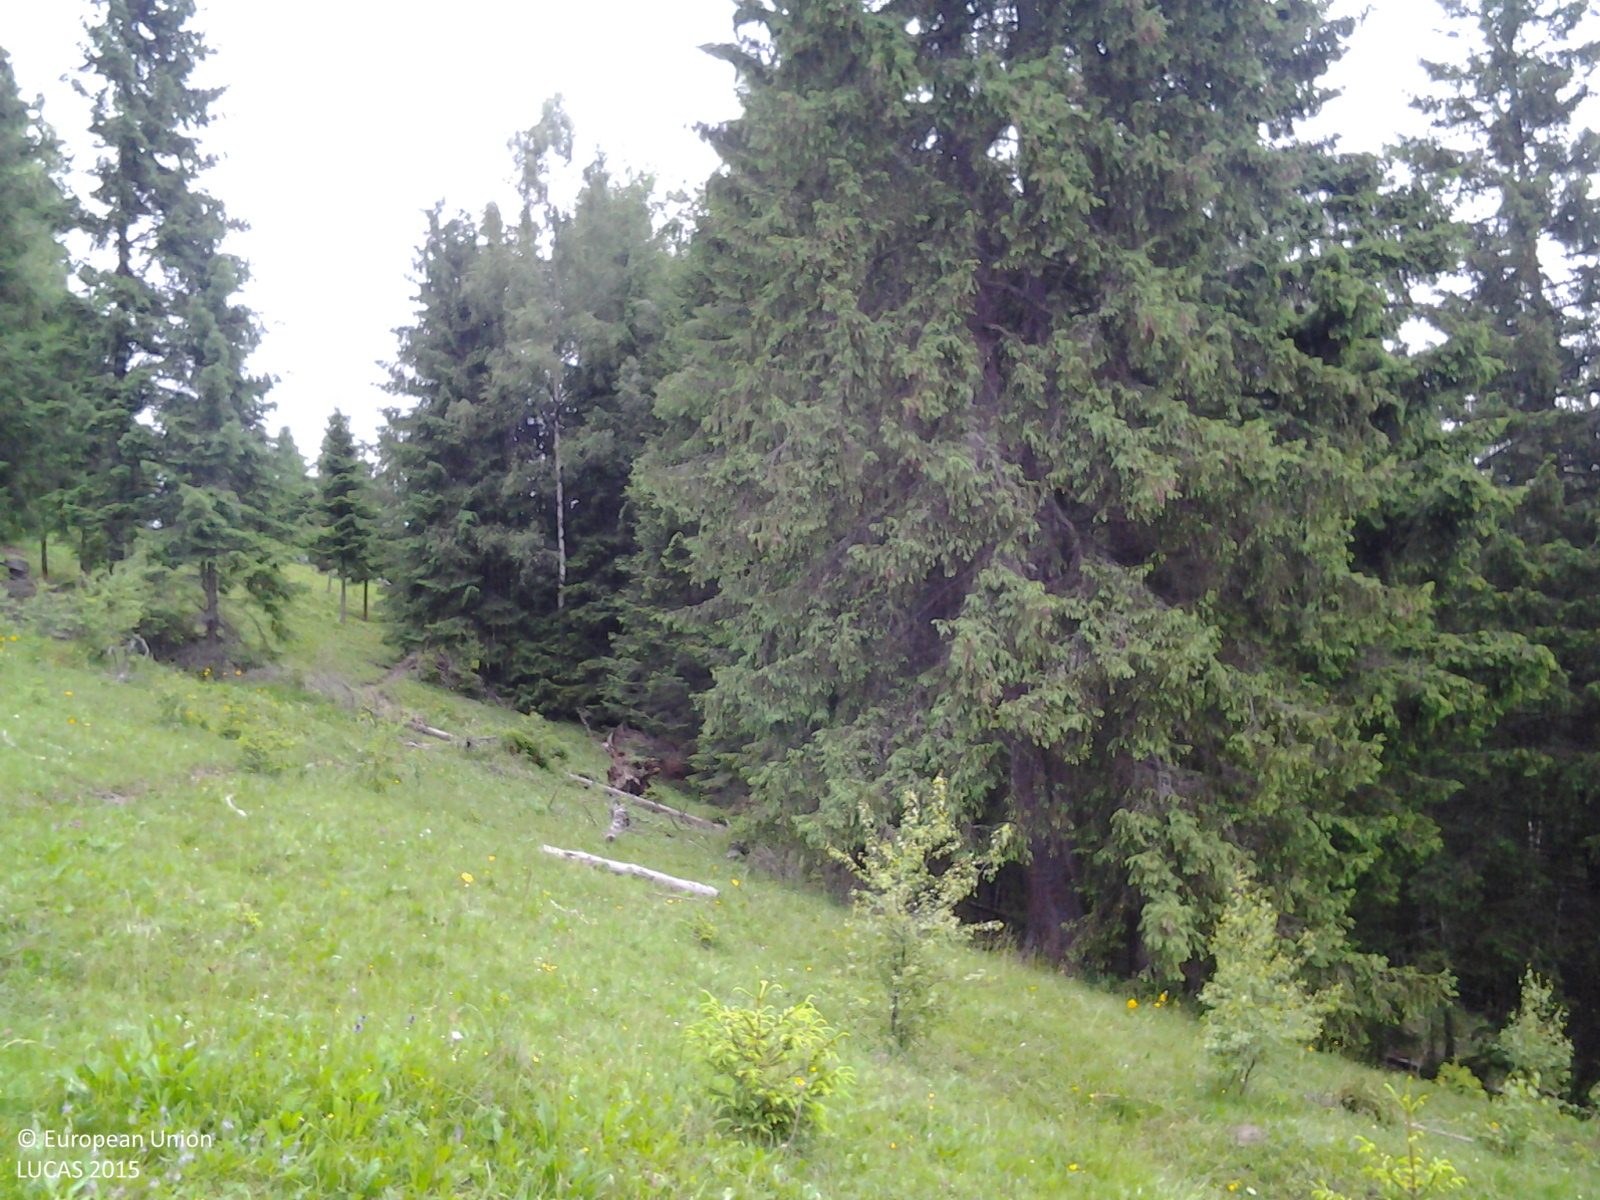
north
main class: Grassland
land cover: Grassland with sparse tree/shrub cover
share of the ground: > 75 %
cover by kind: herbaceous plants 85 %, shrubs 10 %, coniferous forest trees 5 %
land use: Agriculture (excluding fallow land and kitchen gardens)
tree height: > 5 m
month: June
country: RO
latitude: 47.7553
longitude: 25.1433
